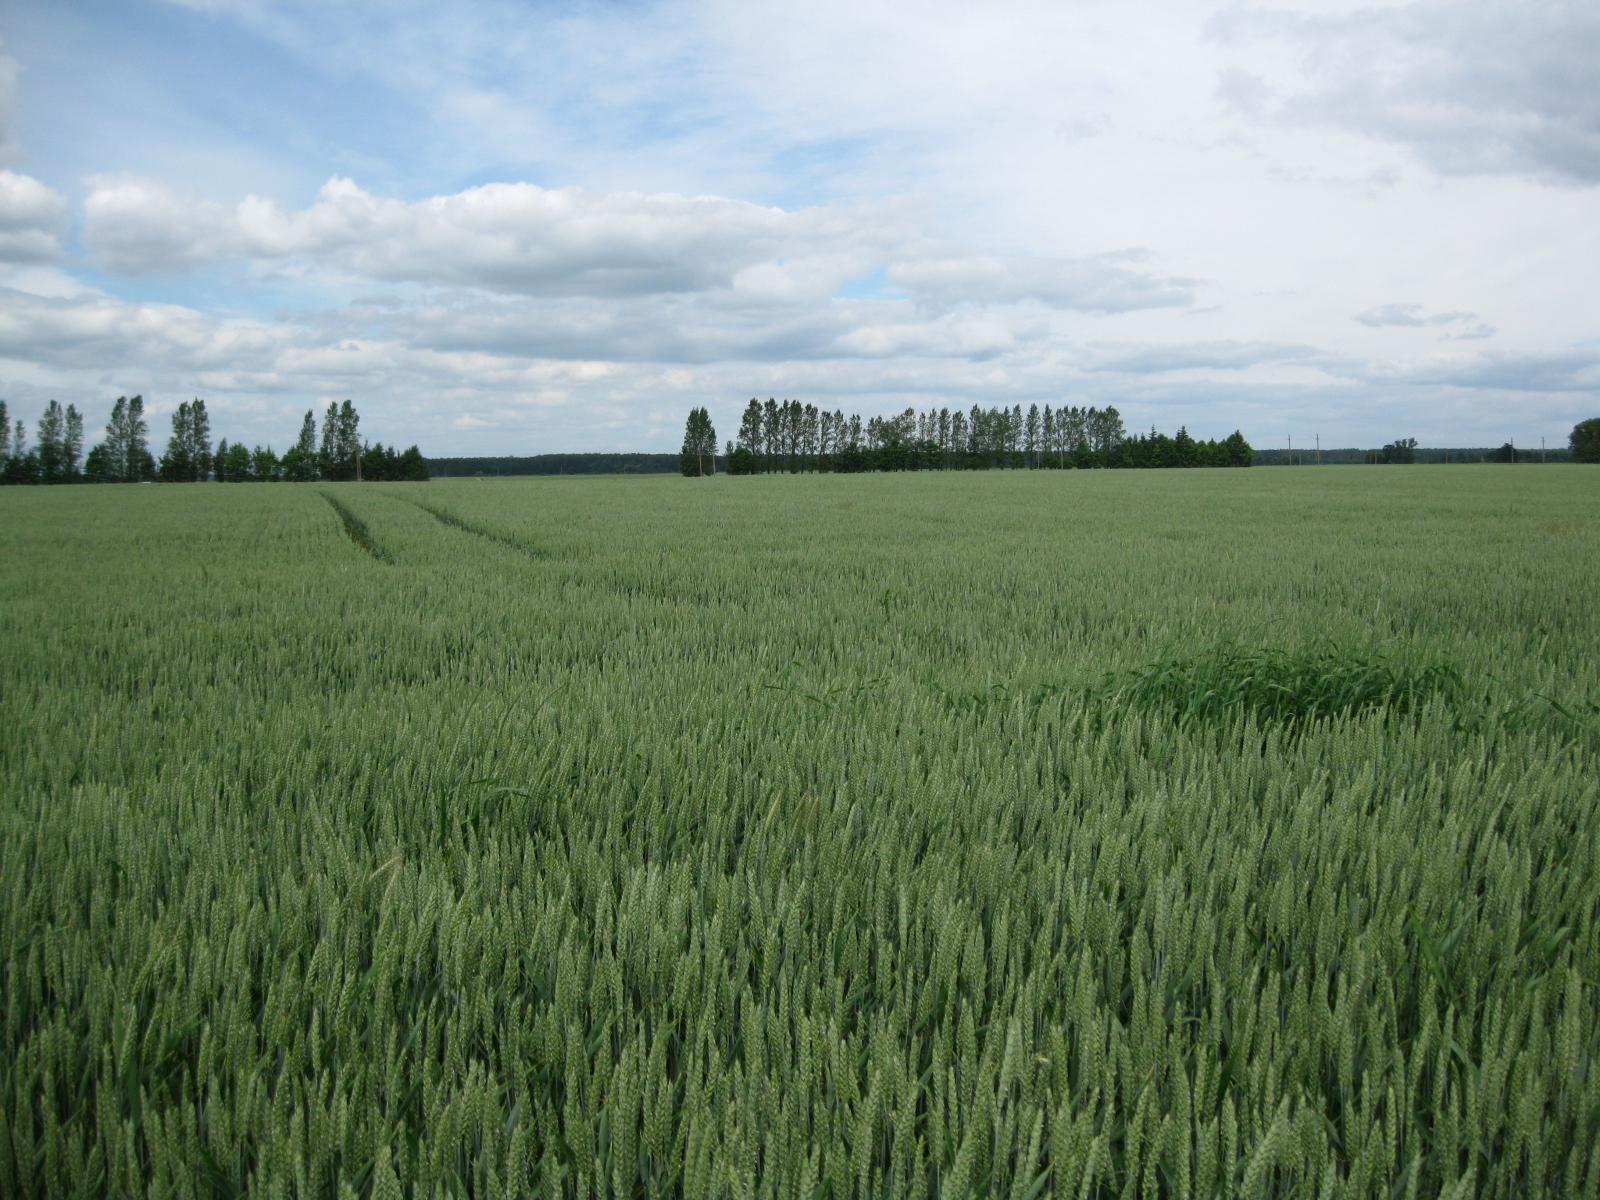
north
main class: Cropland
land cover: Common wheat
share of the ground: > 75 %
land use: Agriculture (excluding fallow land and kitchen gardens)
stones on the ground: < 10 %
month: June
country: LT
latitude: 55.5900
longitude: 24.2313
